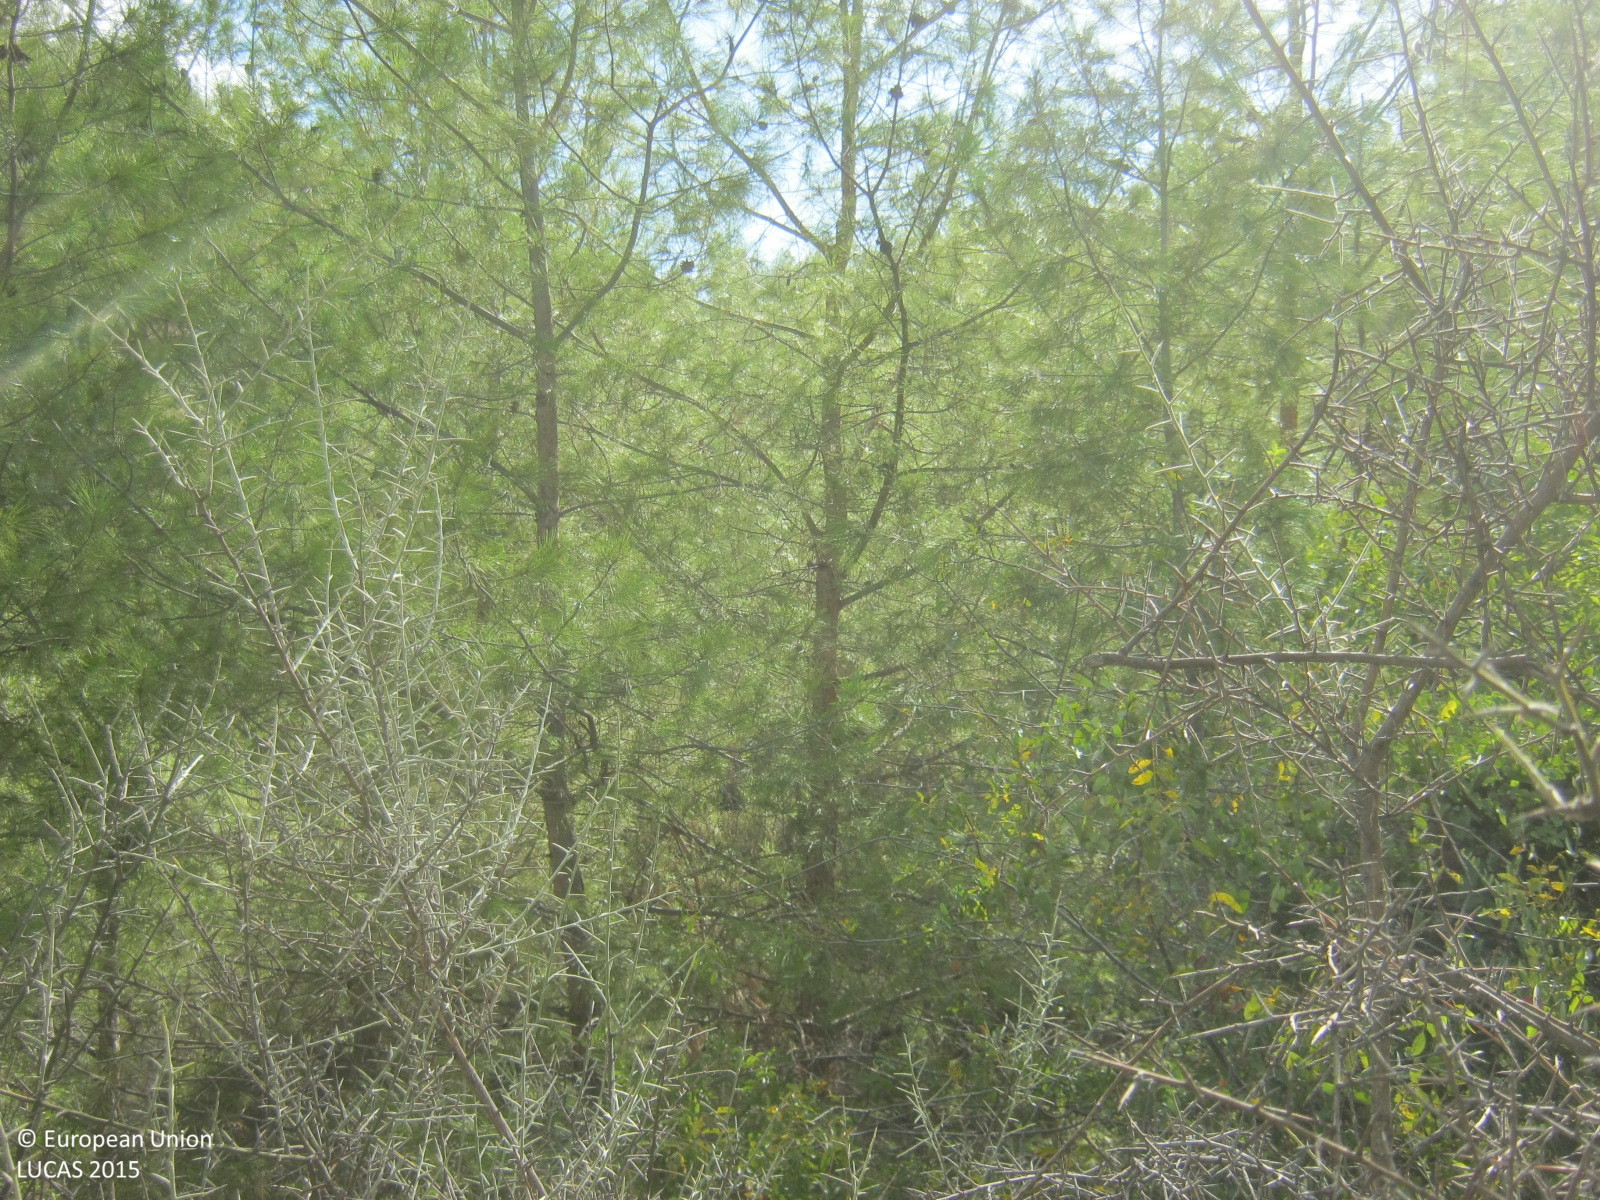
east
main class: Woodland
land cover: Pine dominated coniferous woodland
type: coniferous forest of the mediterranean region
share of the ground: > 75 %
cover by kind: coniferous forest trees 75 %, shrubs 15 %, herbaceous plants 5 %, unconsolidated bare surface 5 %
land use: Forestry
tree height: > 5 m
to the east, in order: Pine dominated coniferous woodland; Tracks; Pine dominated coniferous woodland; Tracks; Pine dominated coniferous woodland
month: September
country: CY
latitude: 35.0492
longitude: 32.8073
